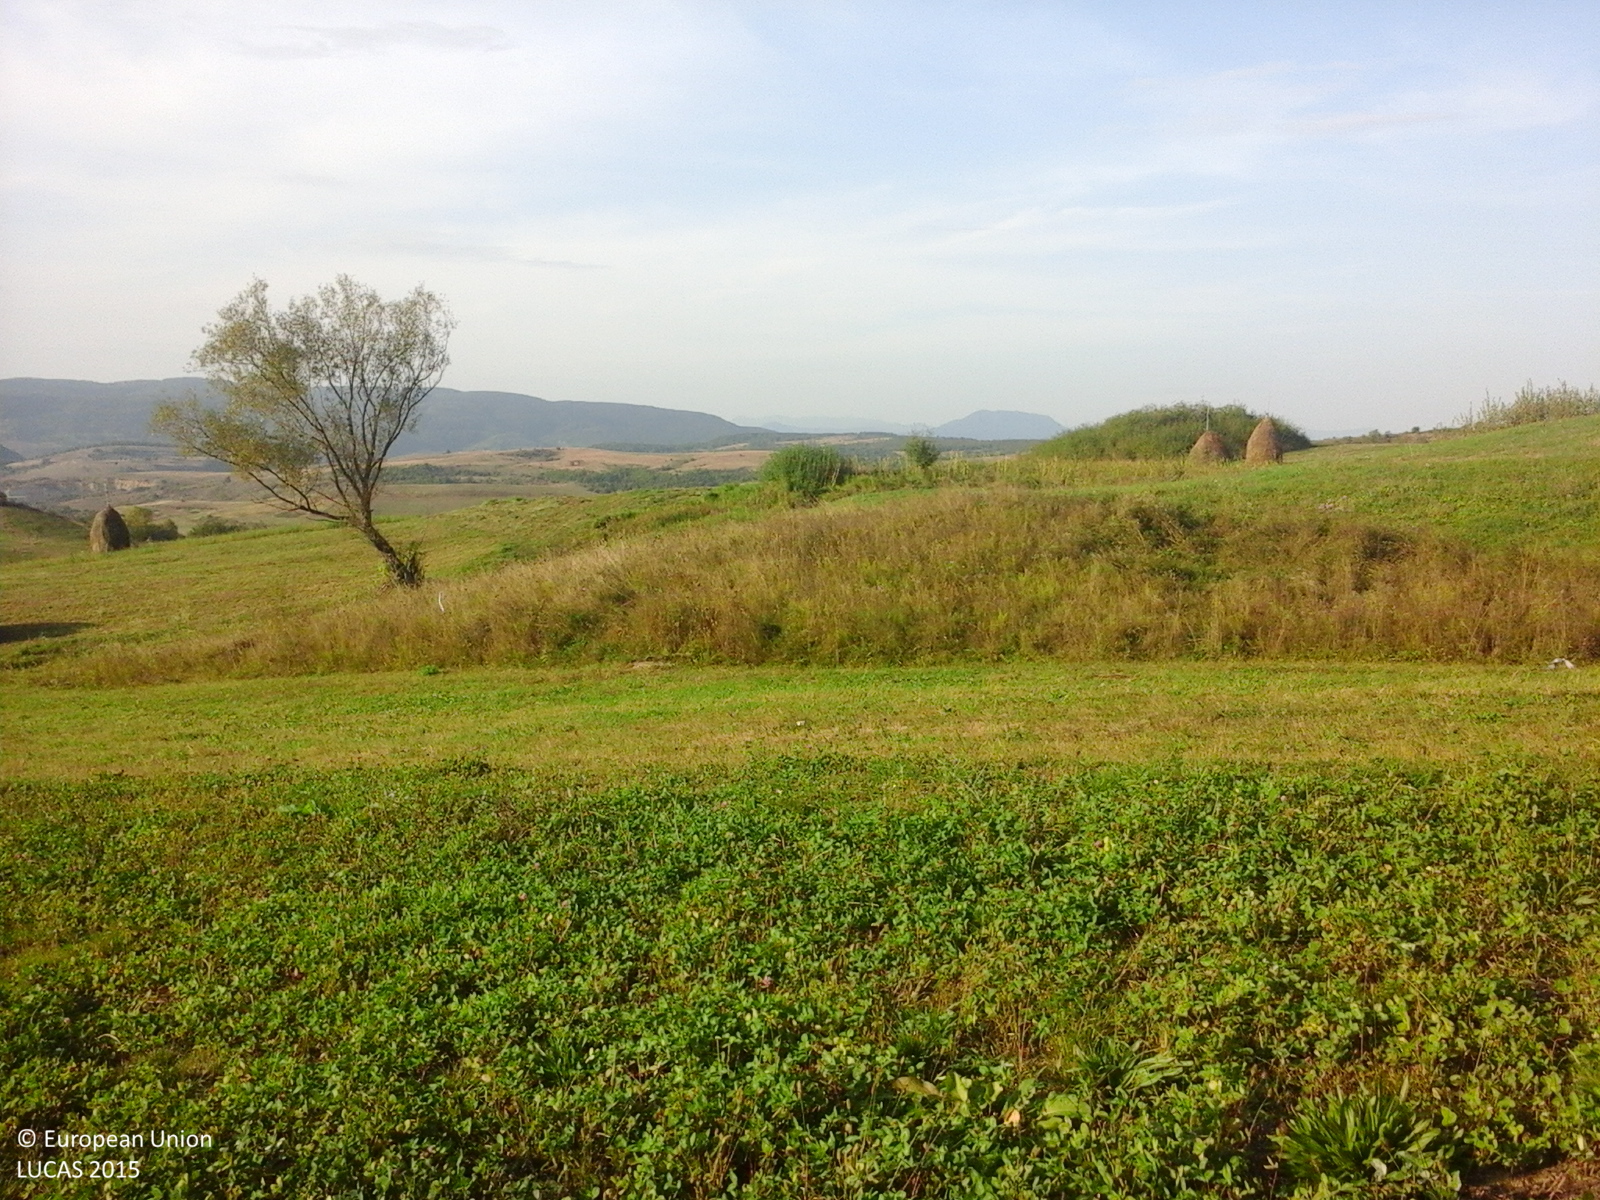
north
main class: Woodland
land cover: Broadleaved woodland
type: broadleaved evergreen forest
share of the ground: > 75 %
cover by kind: broadleaved forest trees 100 %
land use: Semi-natural and natural areas not in use
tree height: > 5 m
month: September
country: RO
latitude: 47.4059
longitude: 23.7941
